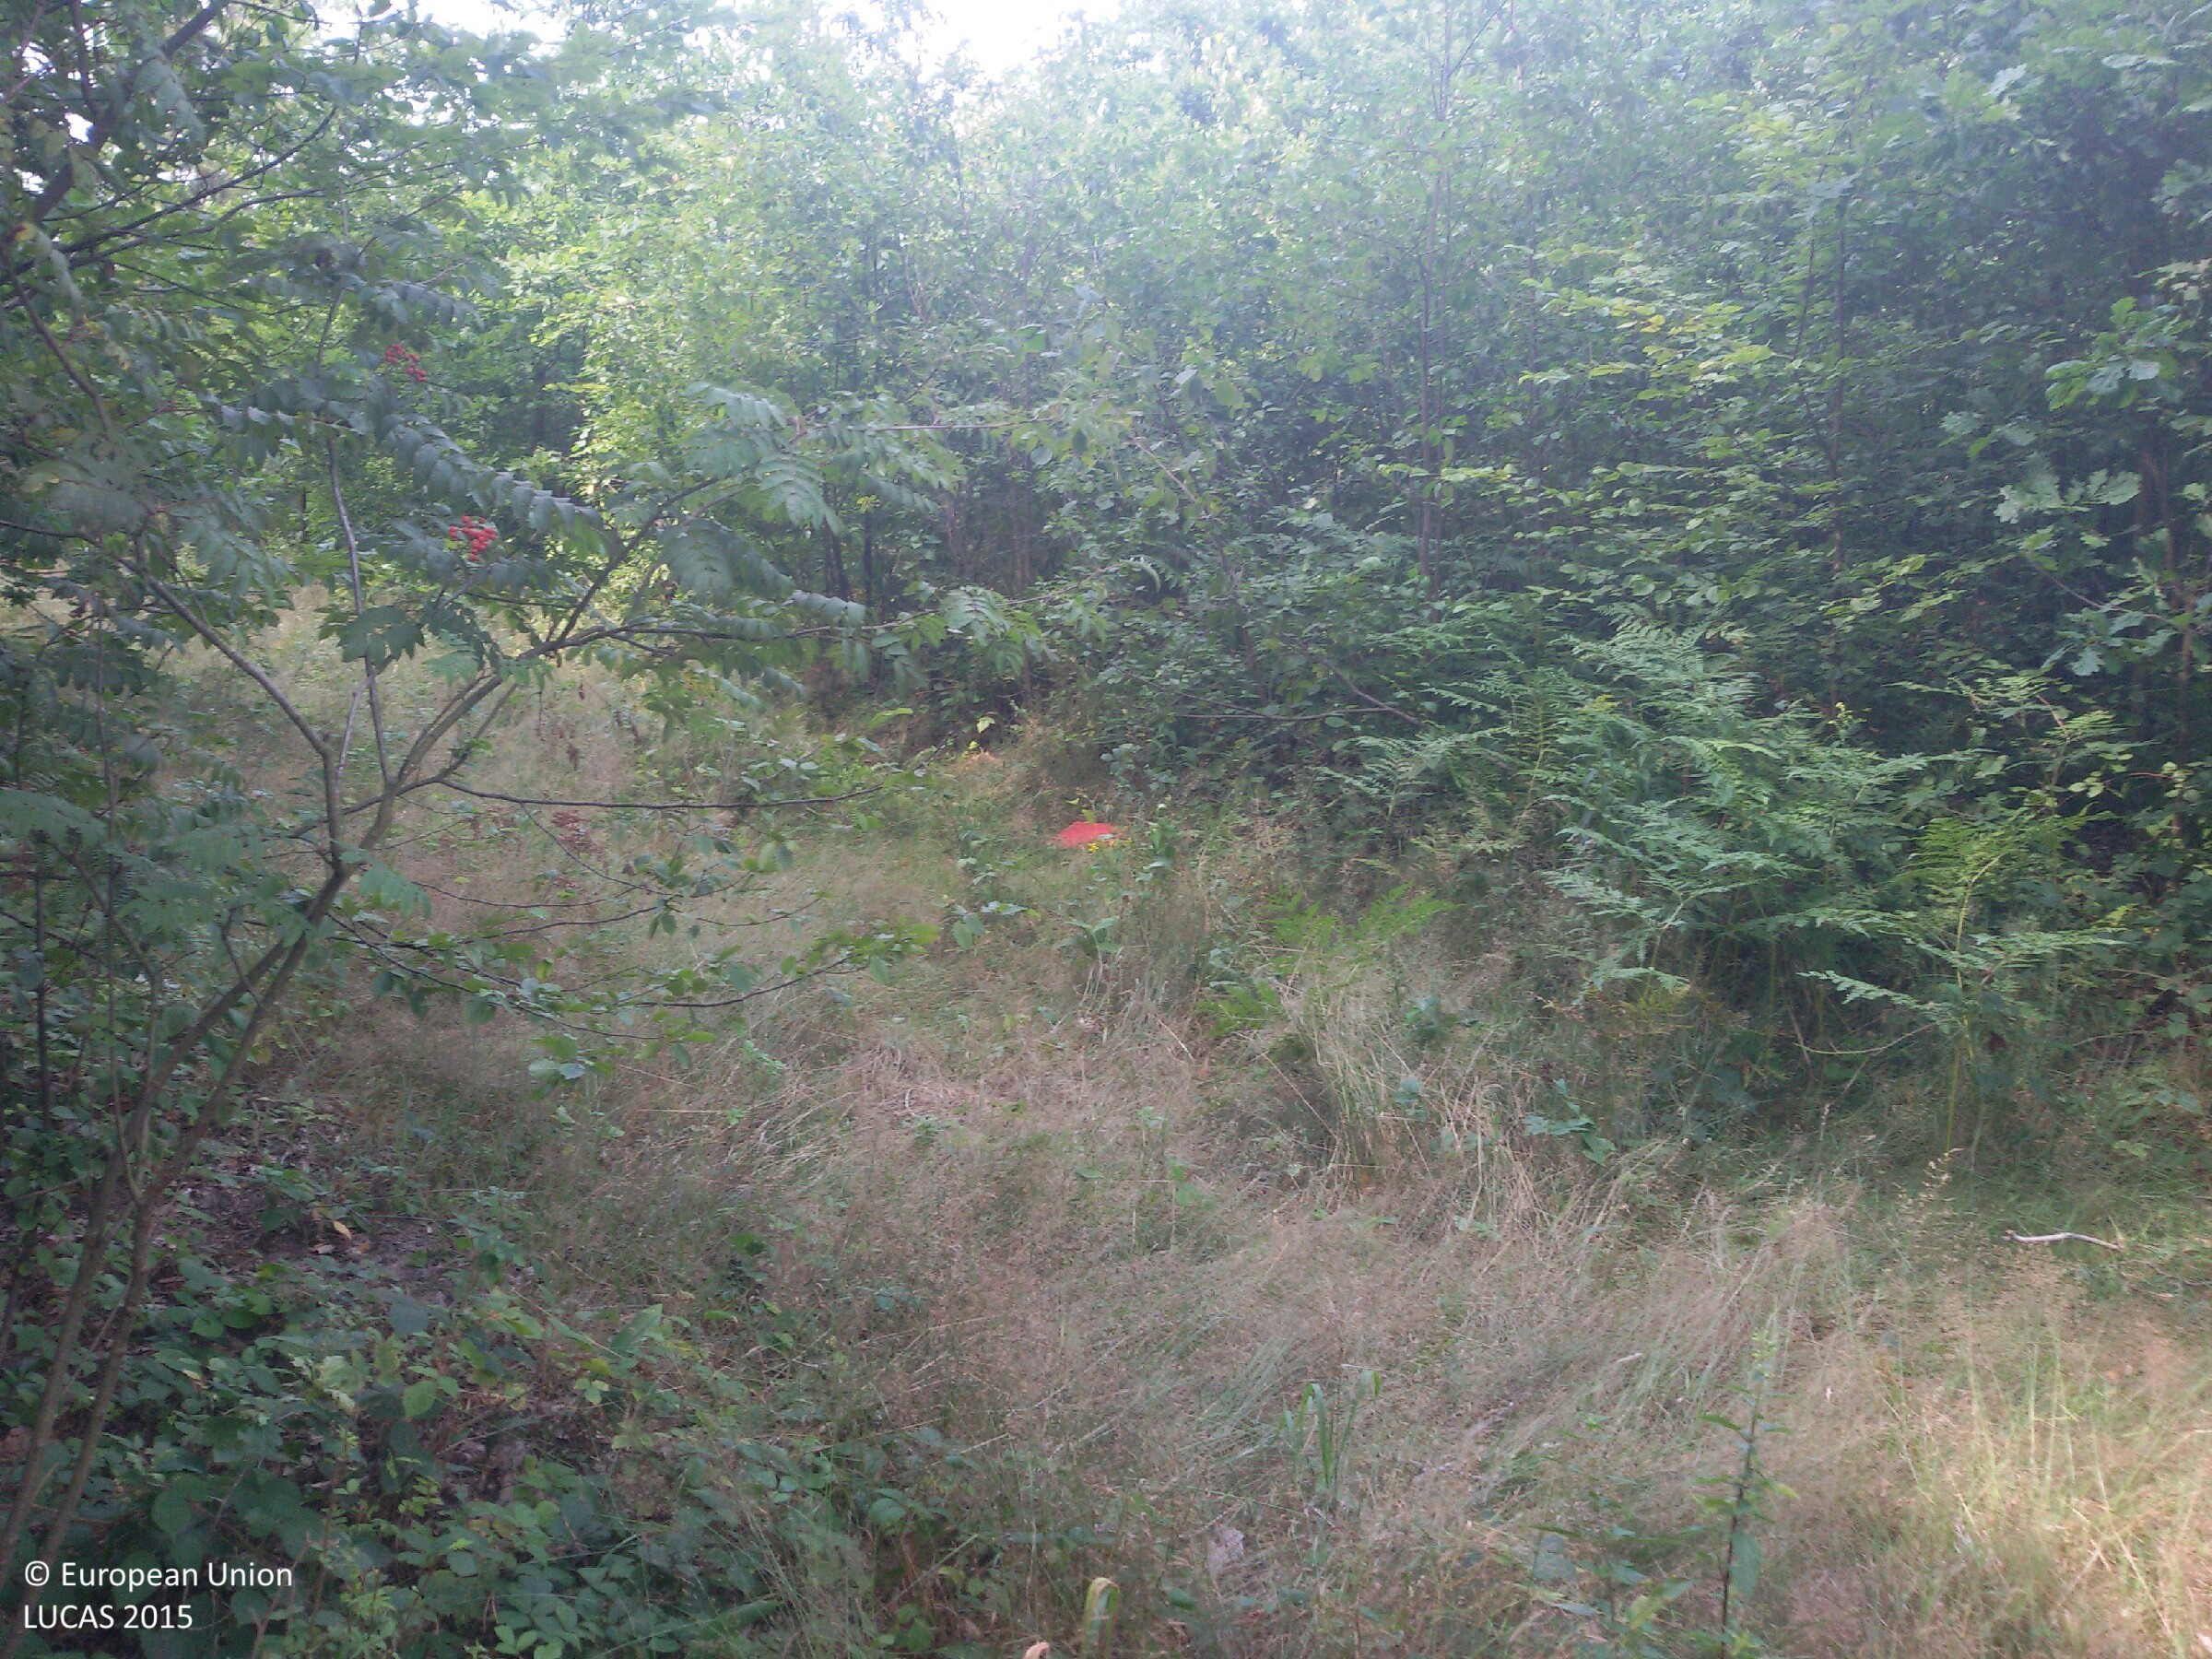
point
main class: Woodland
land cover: Pine dominated mixed woodland
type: hemiboreal forest and nemoral coniferous forest and mixed broadleaved-coniferous forest
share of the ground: > 75 %
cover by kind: coniferous forest trees 75 %, broadleaved forest trees 25 %
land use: Forestry
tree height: > 5 m
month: July
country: PL
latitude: 50.4706
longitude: 21.3341
